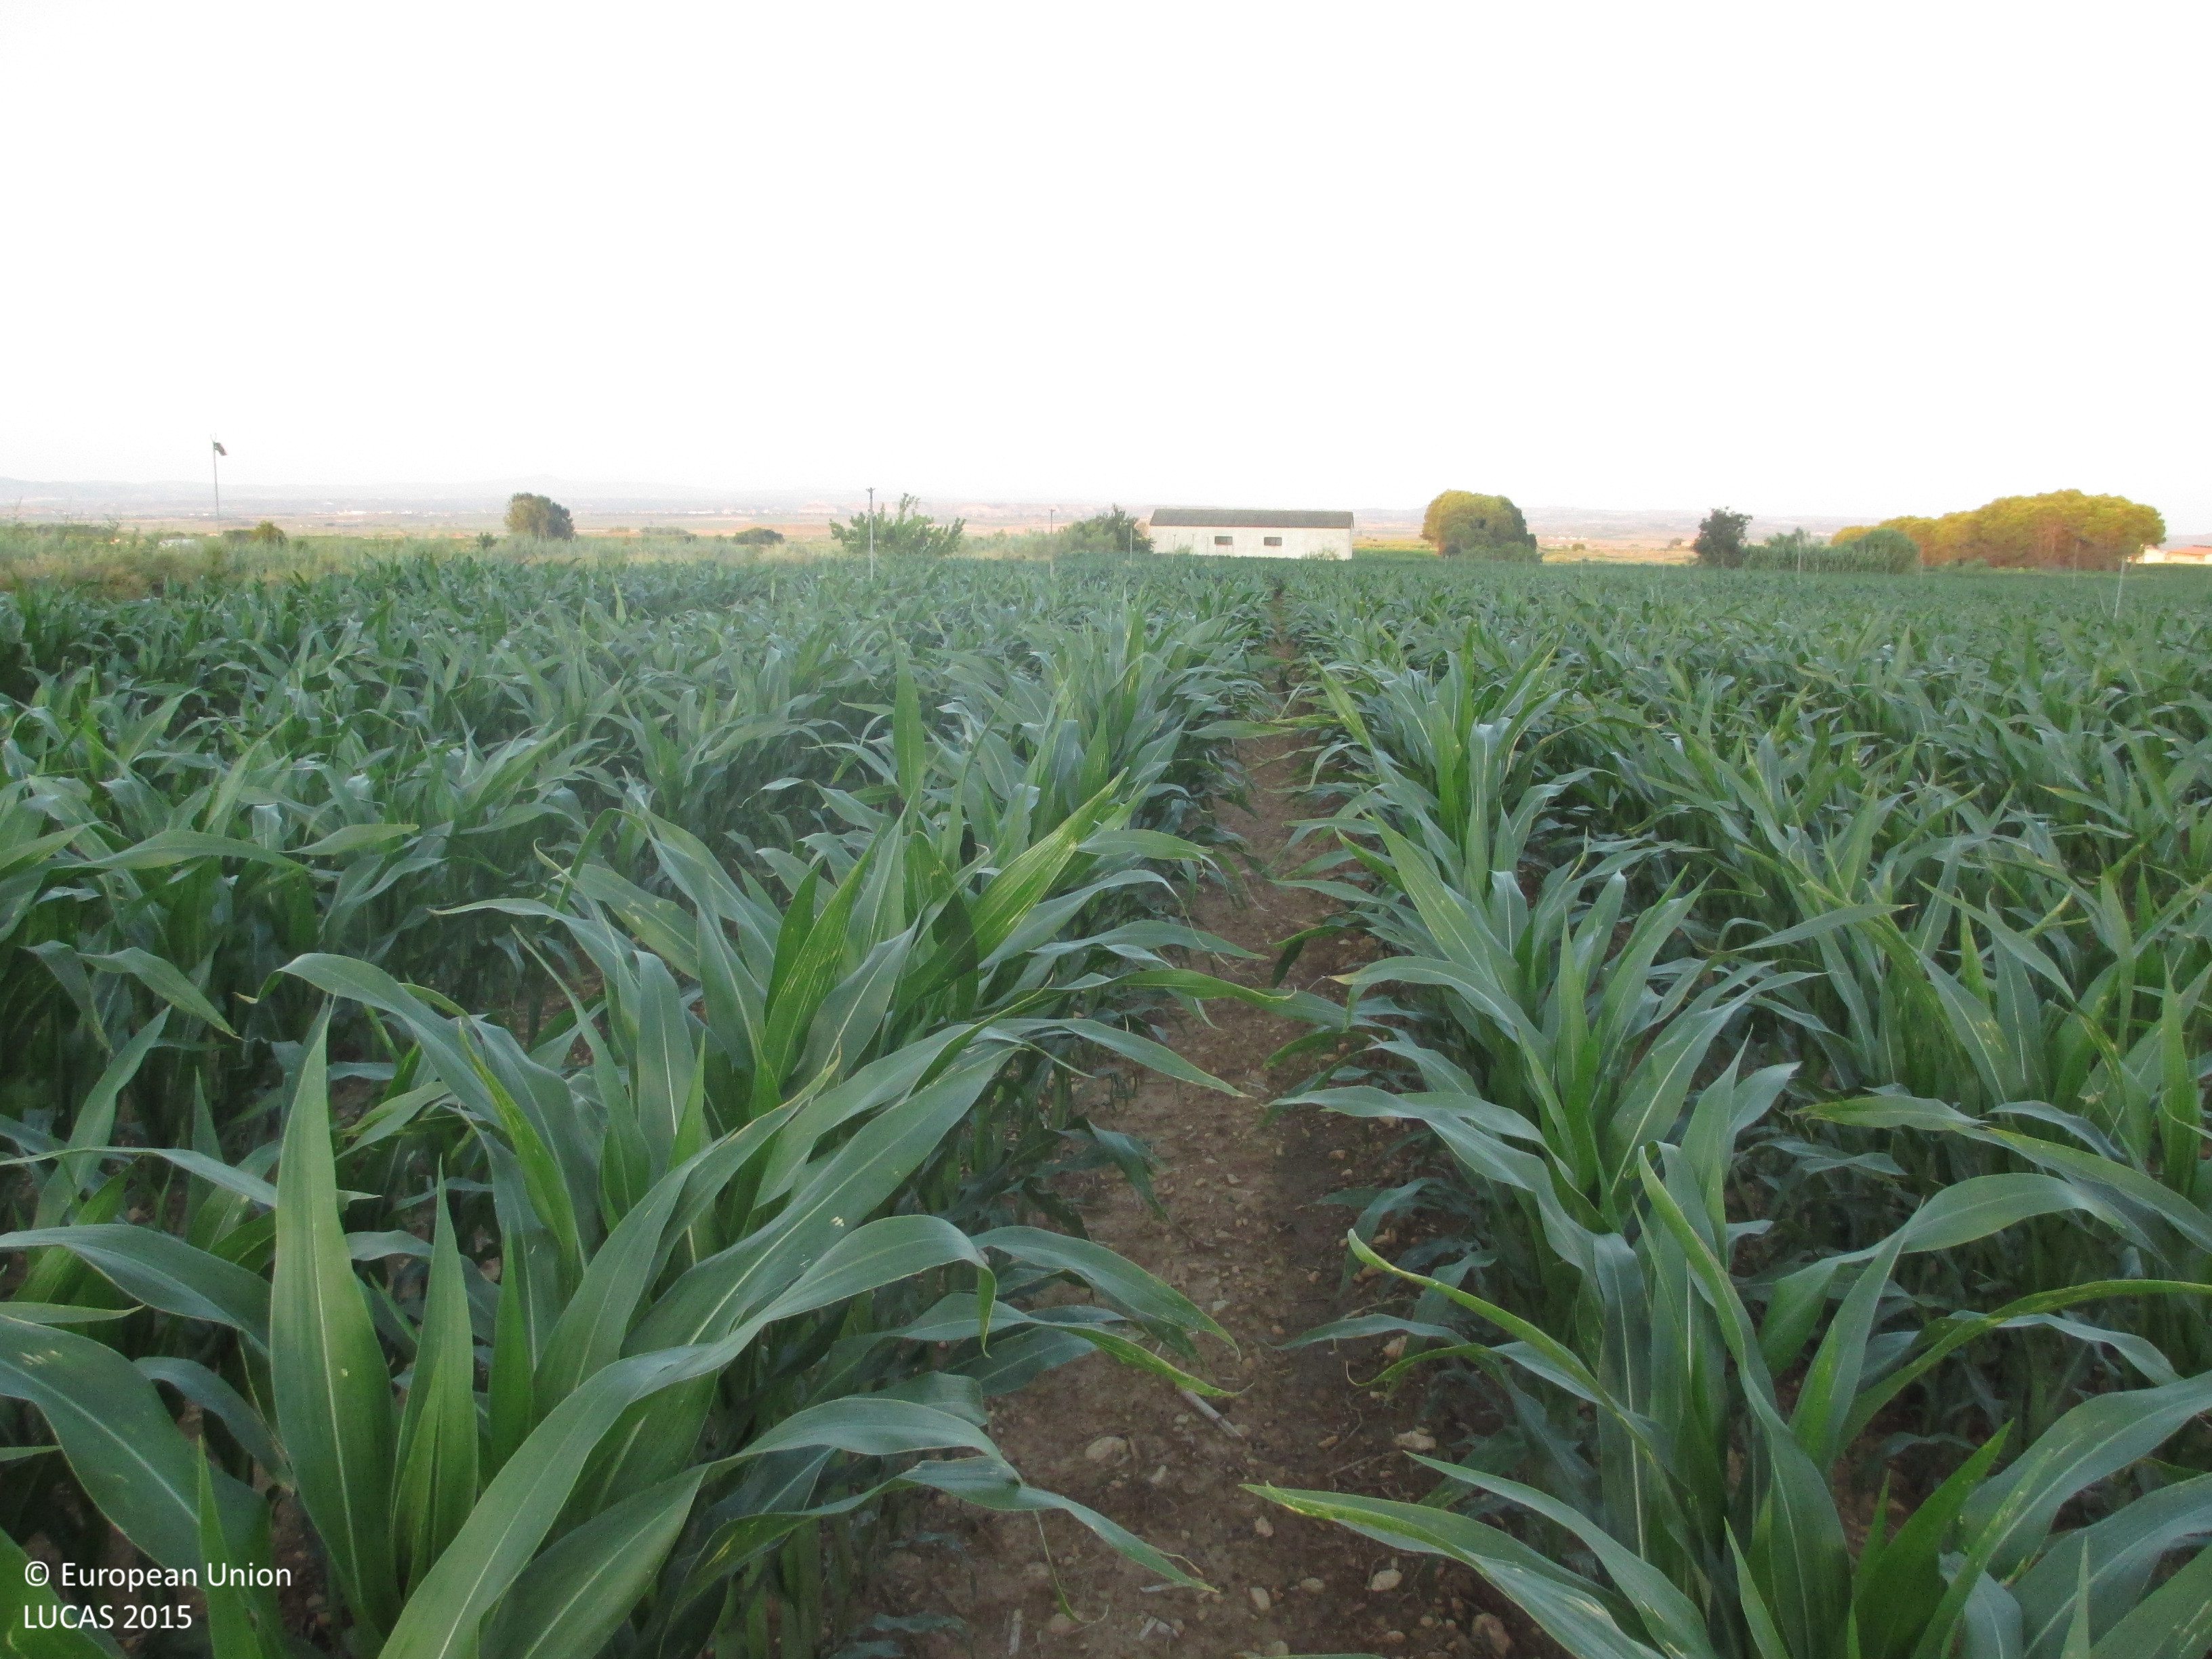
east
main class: Cropland
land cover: Maize
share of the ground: > 75 %
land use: Agriculture (excluding fallow land and kitchen gardens)
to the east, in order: Maize; Single bushes/trees; Shruby margins; Rivers and streams; Artificial constructions in urban areas
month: July
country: ES
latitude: 41.8891
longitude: 0.0396
